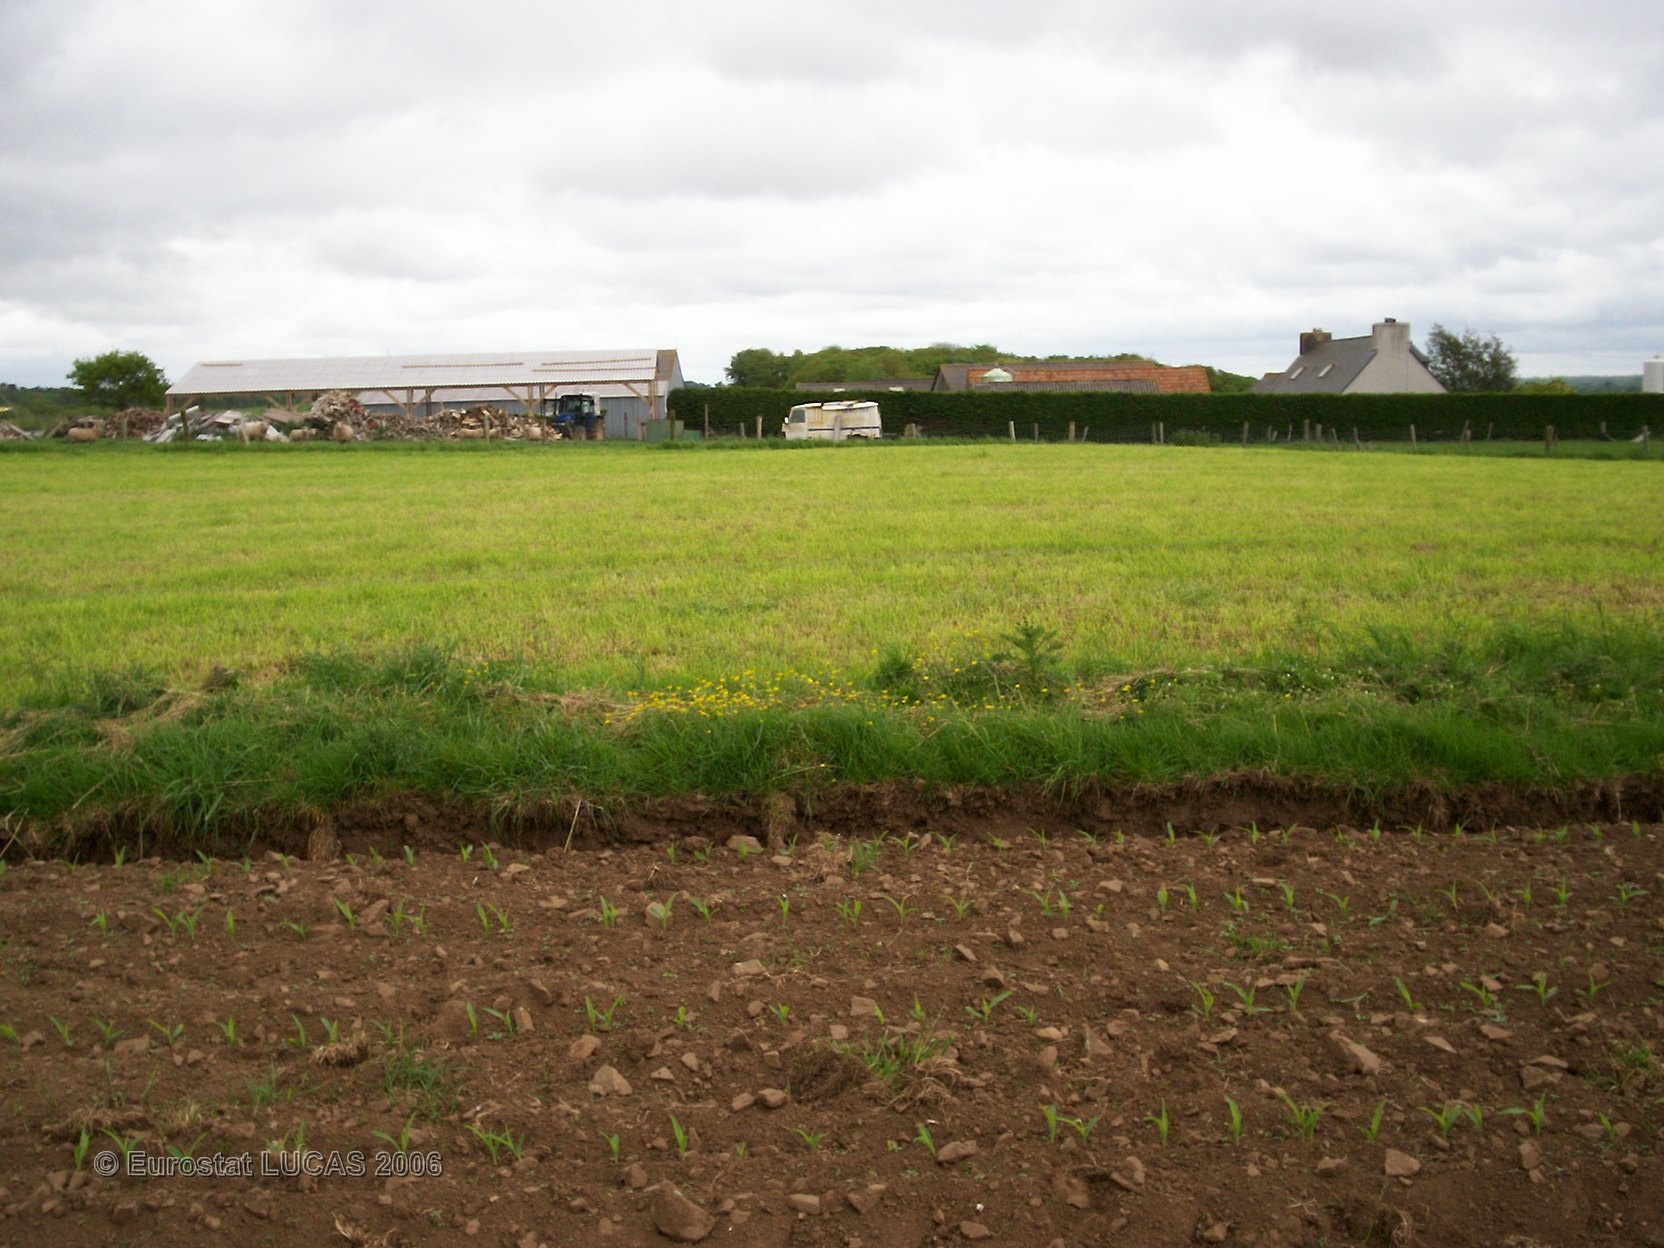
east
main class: Cropland
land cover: Maize
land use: Agriculture (excluding fallow land and kitchen gardens)
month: May
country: FR
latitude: 48.6168
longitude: -3.7440
